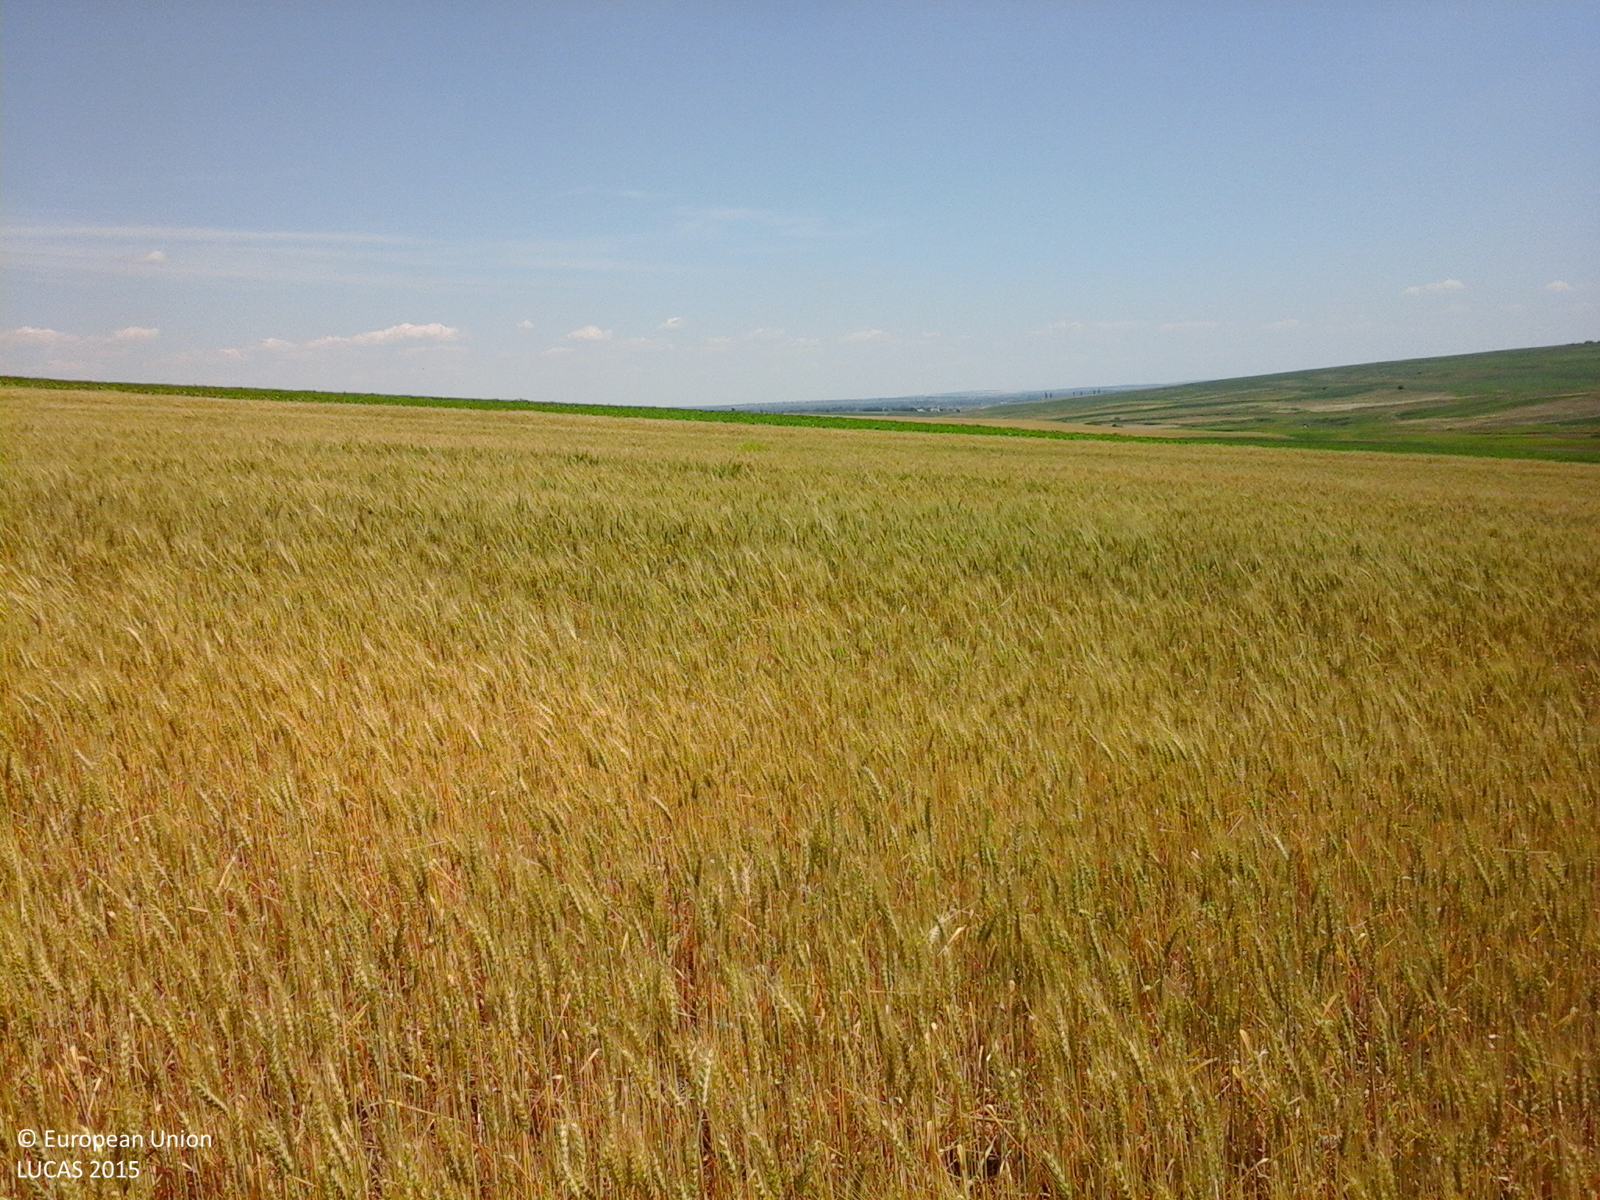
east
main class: Cropland
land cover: Common wheat
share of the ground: > 75 %
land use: Agriculture (excluding fallow land and kitchen gardens)
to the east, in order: Common wheat; Maize; Soya; Sunflower; Soya; Maize; Soya
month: June
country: RO
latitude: 48.1096
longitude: 26.9619
